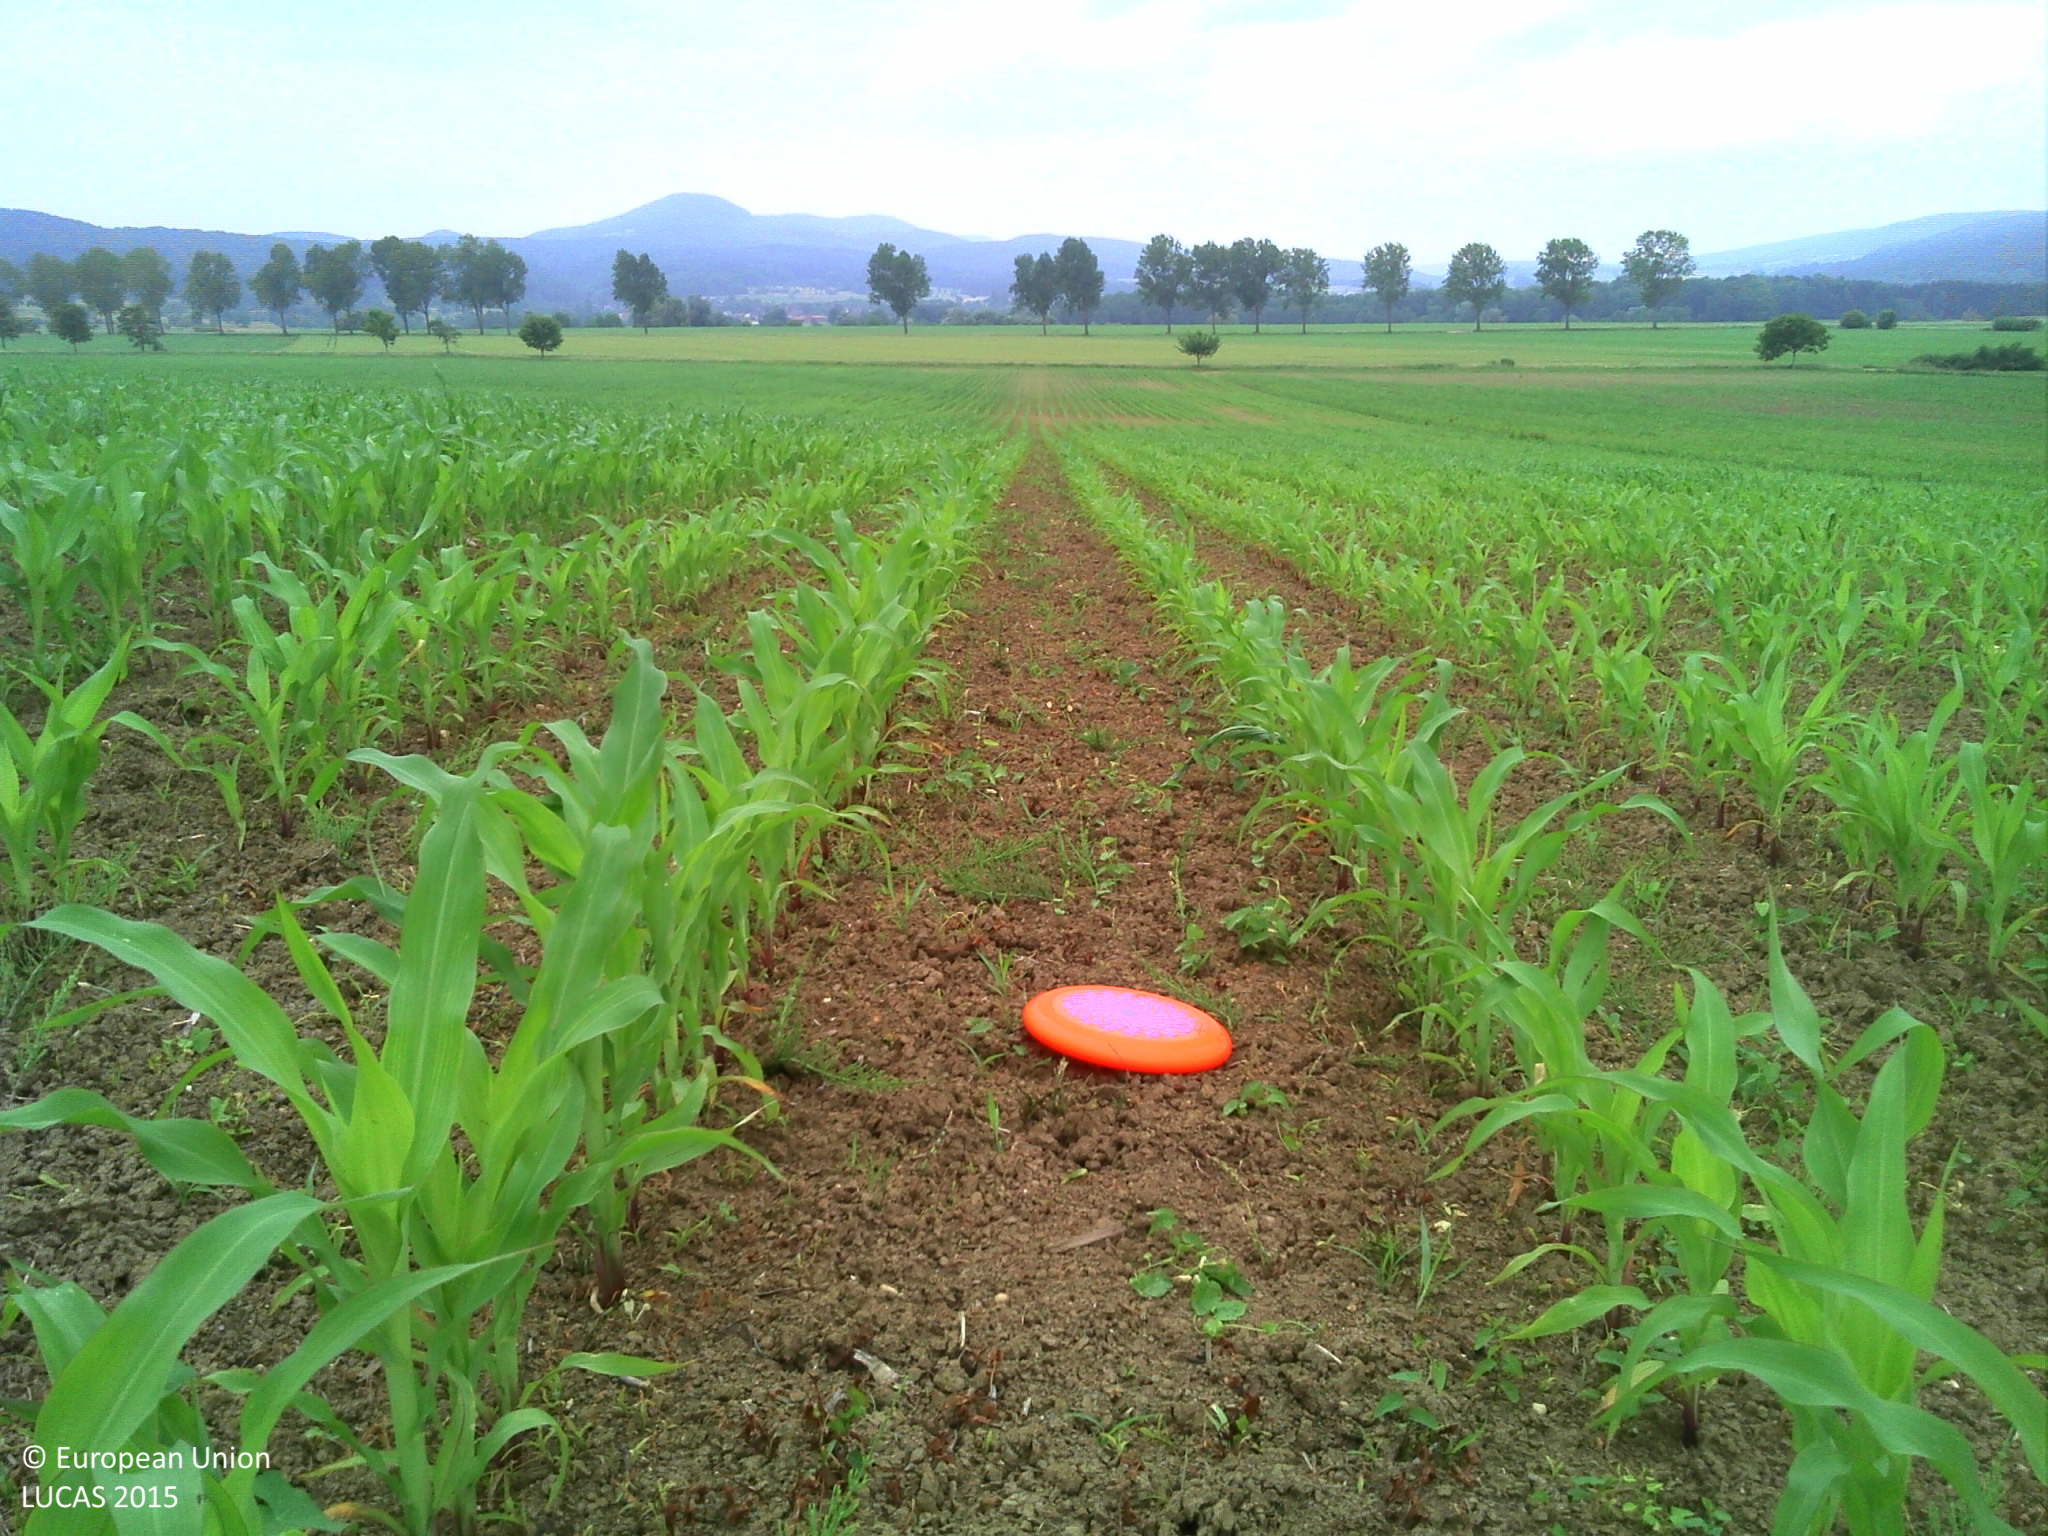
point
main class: Cropland
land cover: Maize
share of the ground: 10 - 25 %
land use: Agriculture (excluding fallow land and kitchen gardens)
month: June
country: FR
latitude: 47.4730
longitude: 7.4144
